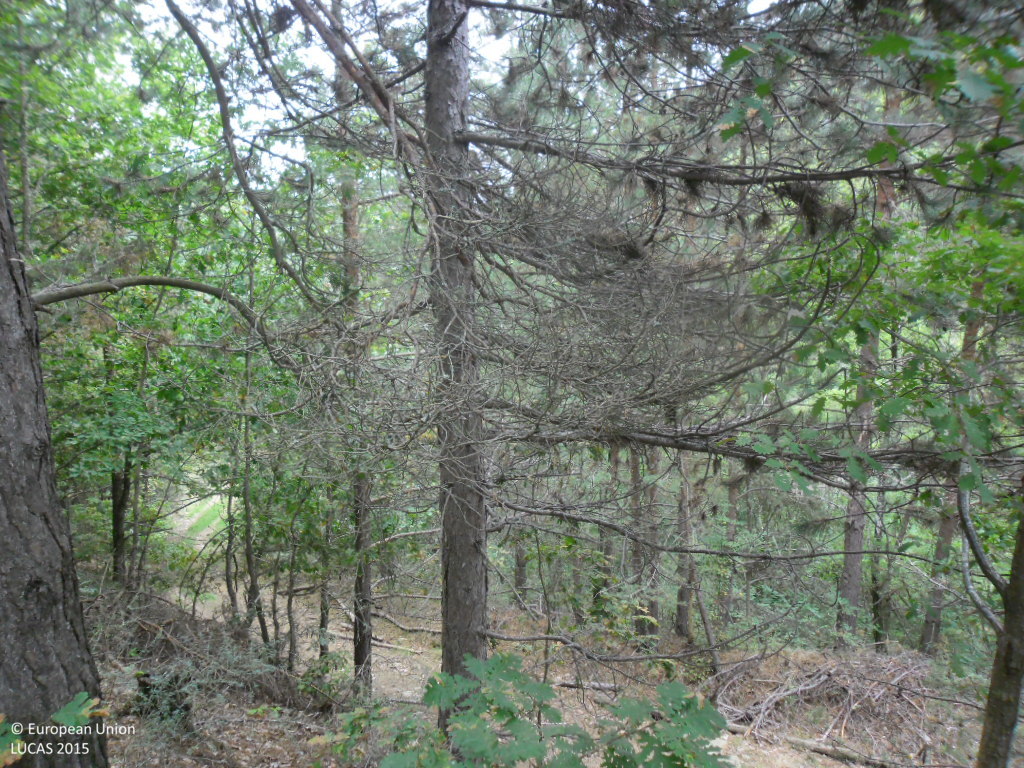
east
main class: Woodland
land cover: Pine dominated coniferous woodland
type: hemiboreal forest and nemoral coniferous forest and mixed broadleaved-coniferous forest
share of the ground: > 75 %
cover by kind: coniferous forest trees 95 %, unconsolidated bare surface 5 %
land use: Forestry
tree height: > 5 m
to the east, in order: Pine dominated coniferous woodland; Tracks; Broadleaved woodland
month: September
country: BG
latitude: 41.6418
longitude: 23.0458
